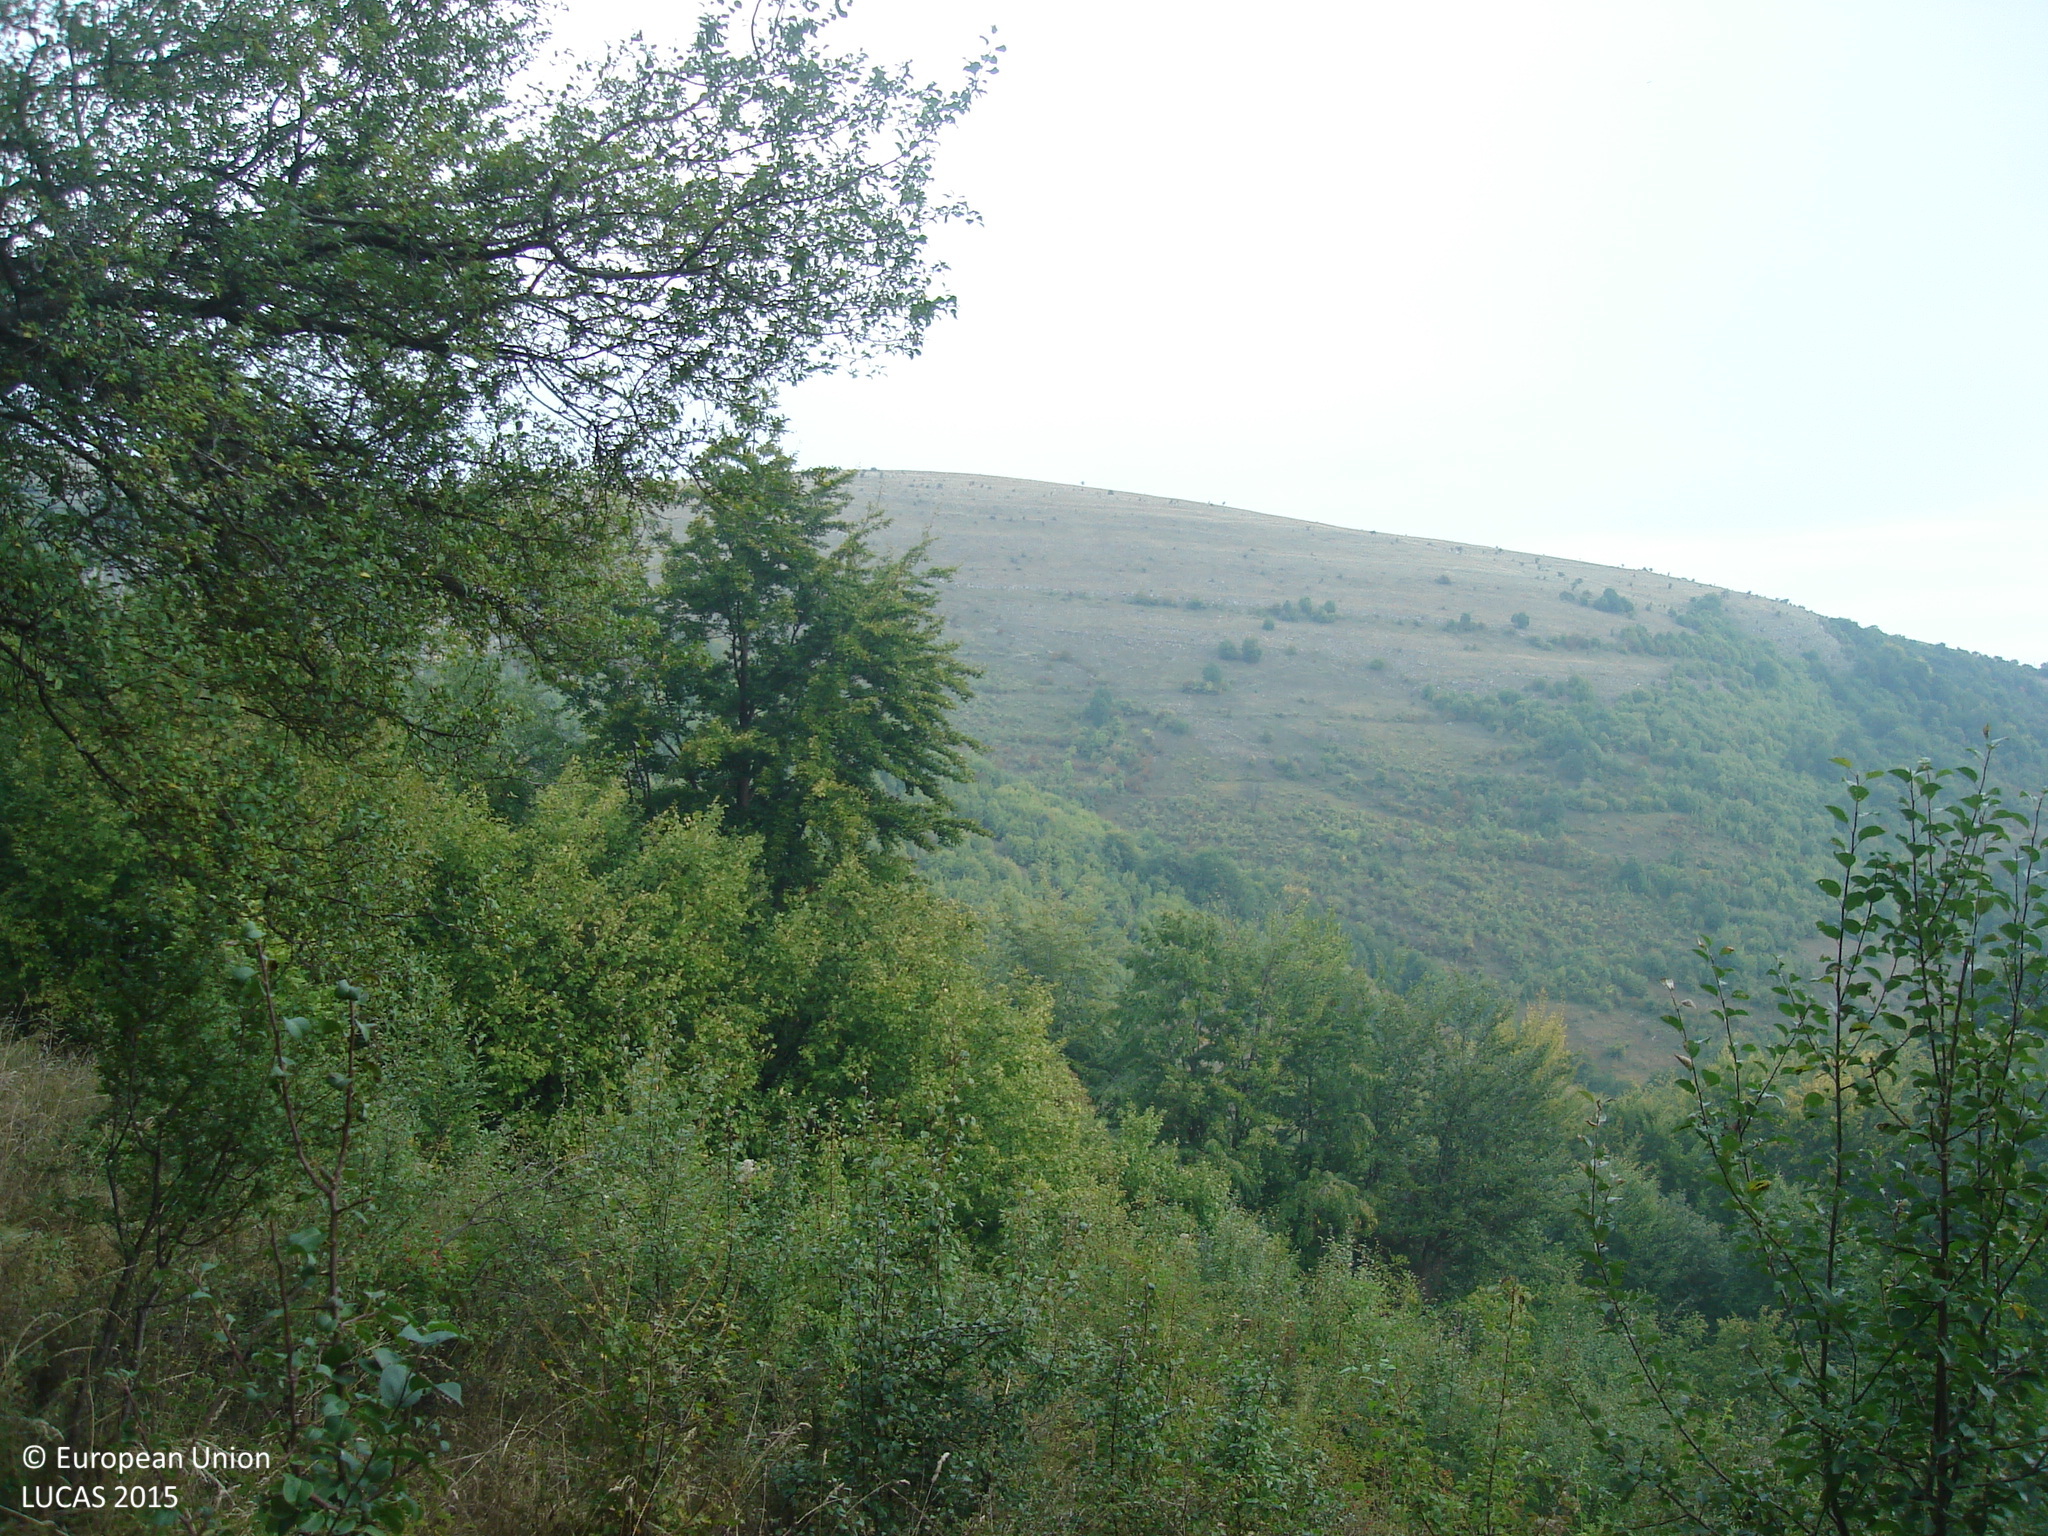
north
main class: Woodland
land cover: Broadleaved woodland
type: mesophytic deciduous forest
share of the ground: 50 - 75 %
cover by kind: broadleaved forest trees 60 %, shrubs 20 %, herbaceous plants 20 %
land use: Semi-natural and natural areas not in use
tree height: > 5 m
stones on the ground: < 10 %
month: October
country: BG
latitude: 43.0506
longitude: 23.3087
